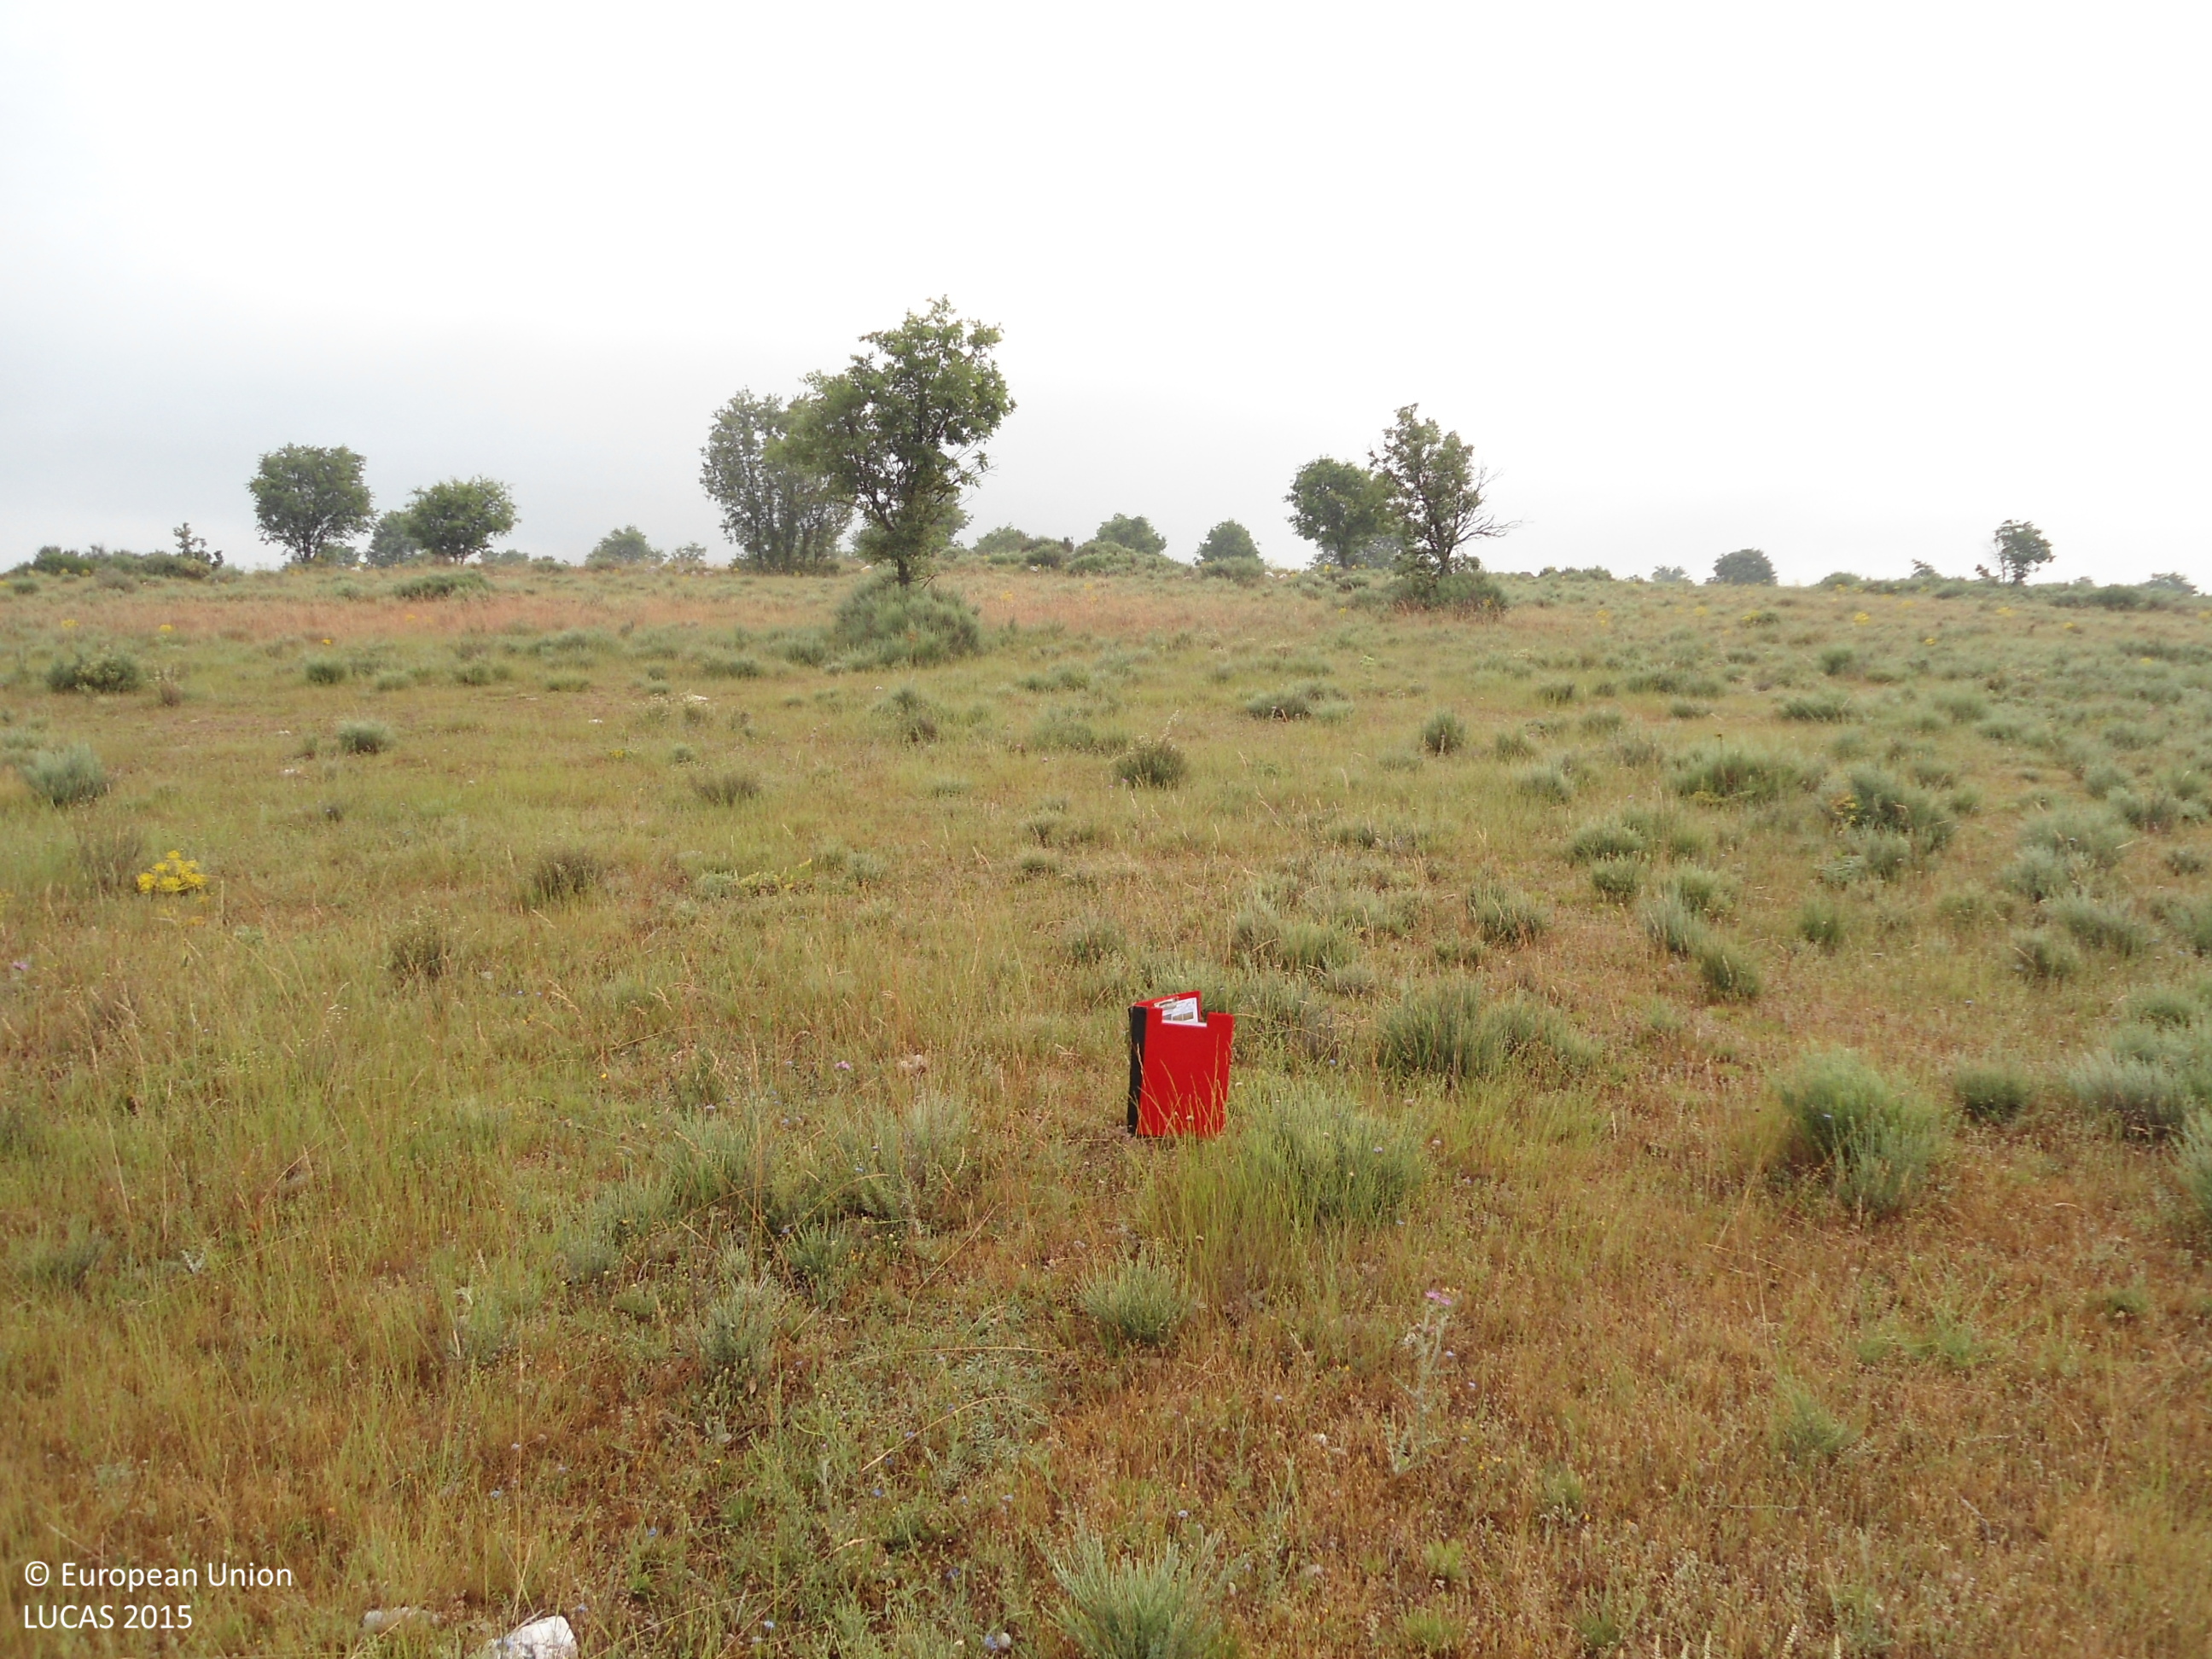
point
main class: Grassland
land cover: Grassland with sparse tree/shrub cover
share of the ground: > 75 %
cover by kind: herbaceous plants 85 %, shrubs 10 %, broadleaved forest trees 5 %
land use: Agriculture (excluding fallow land and kitchen gardens)
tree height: > 5 m
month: June
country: ES
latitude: 42.0531
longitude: -6.3340
